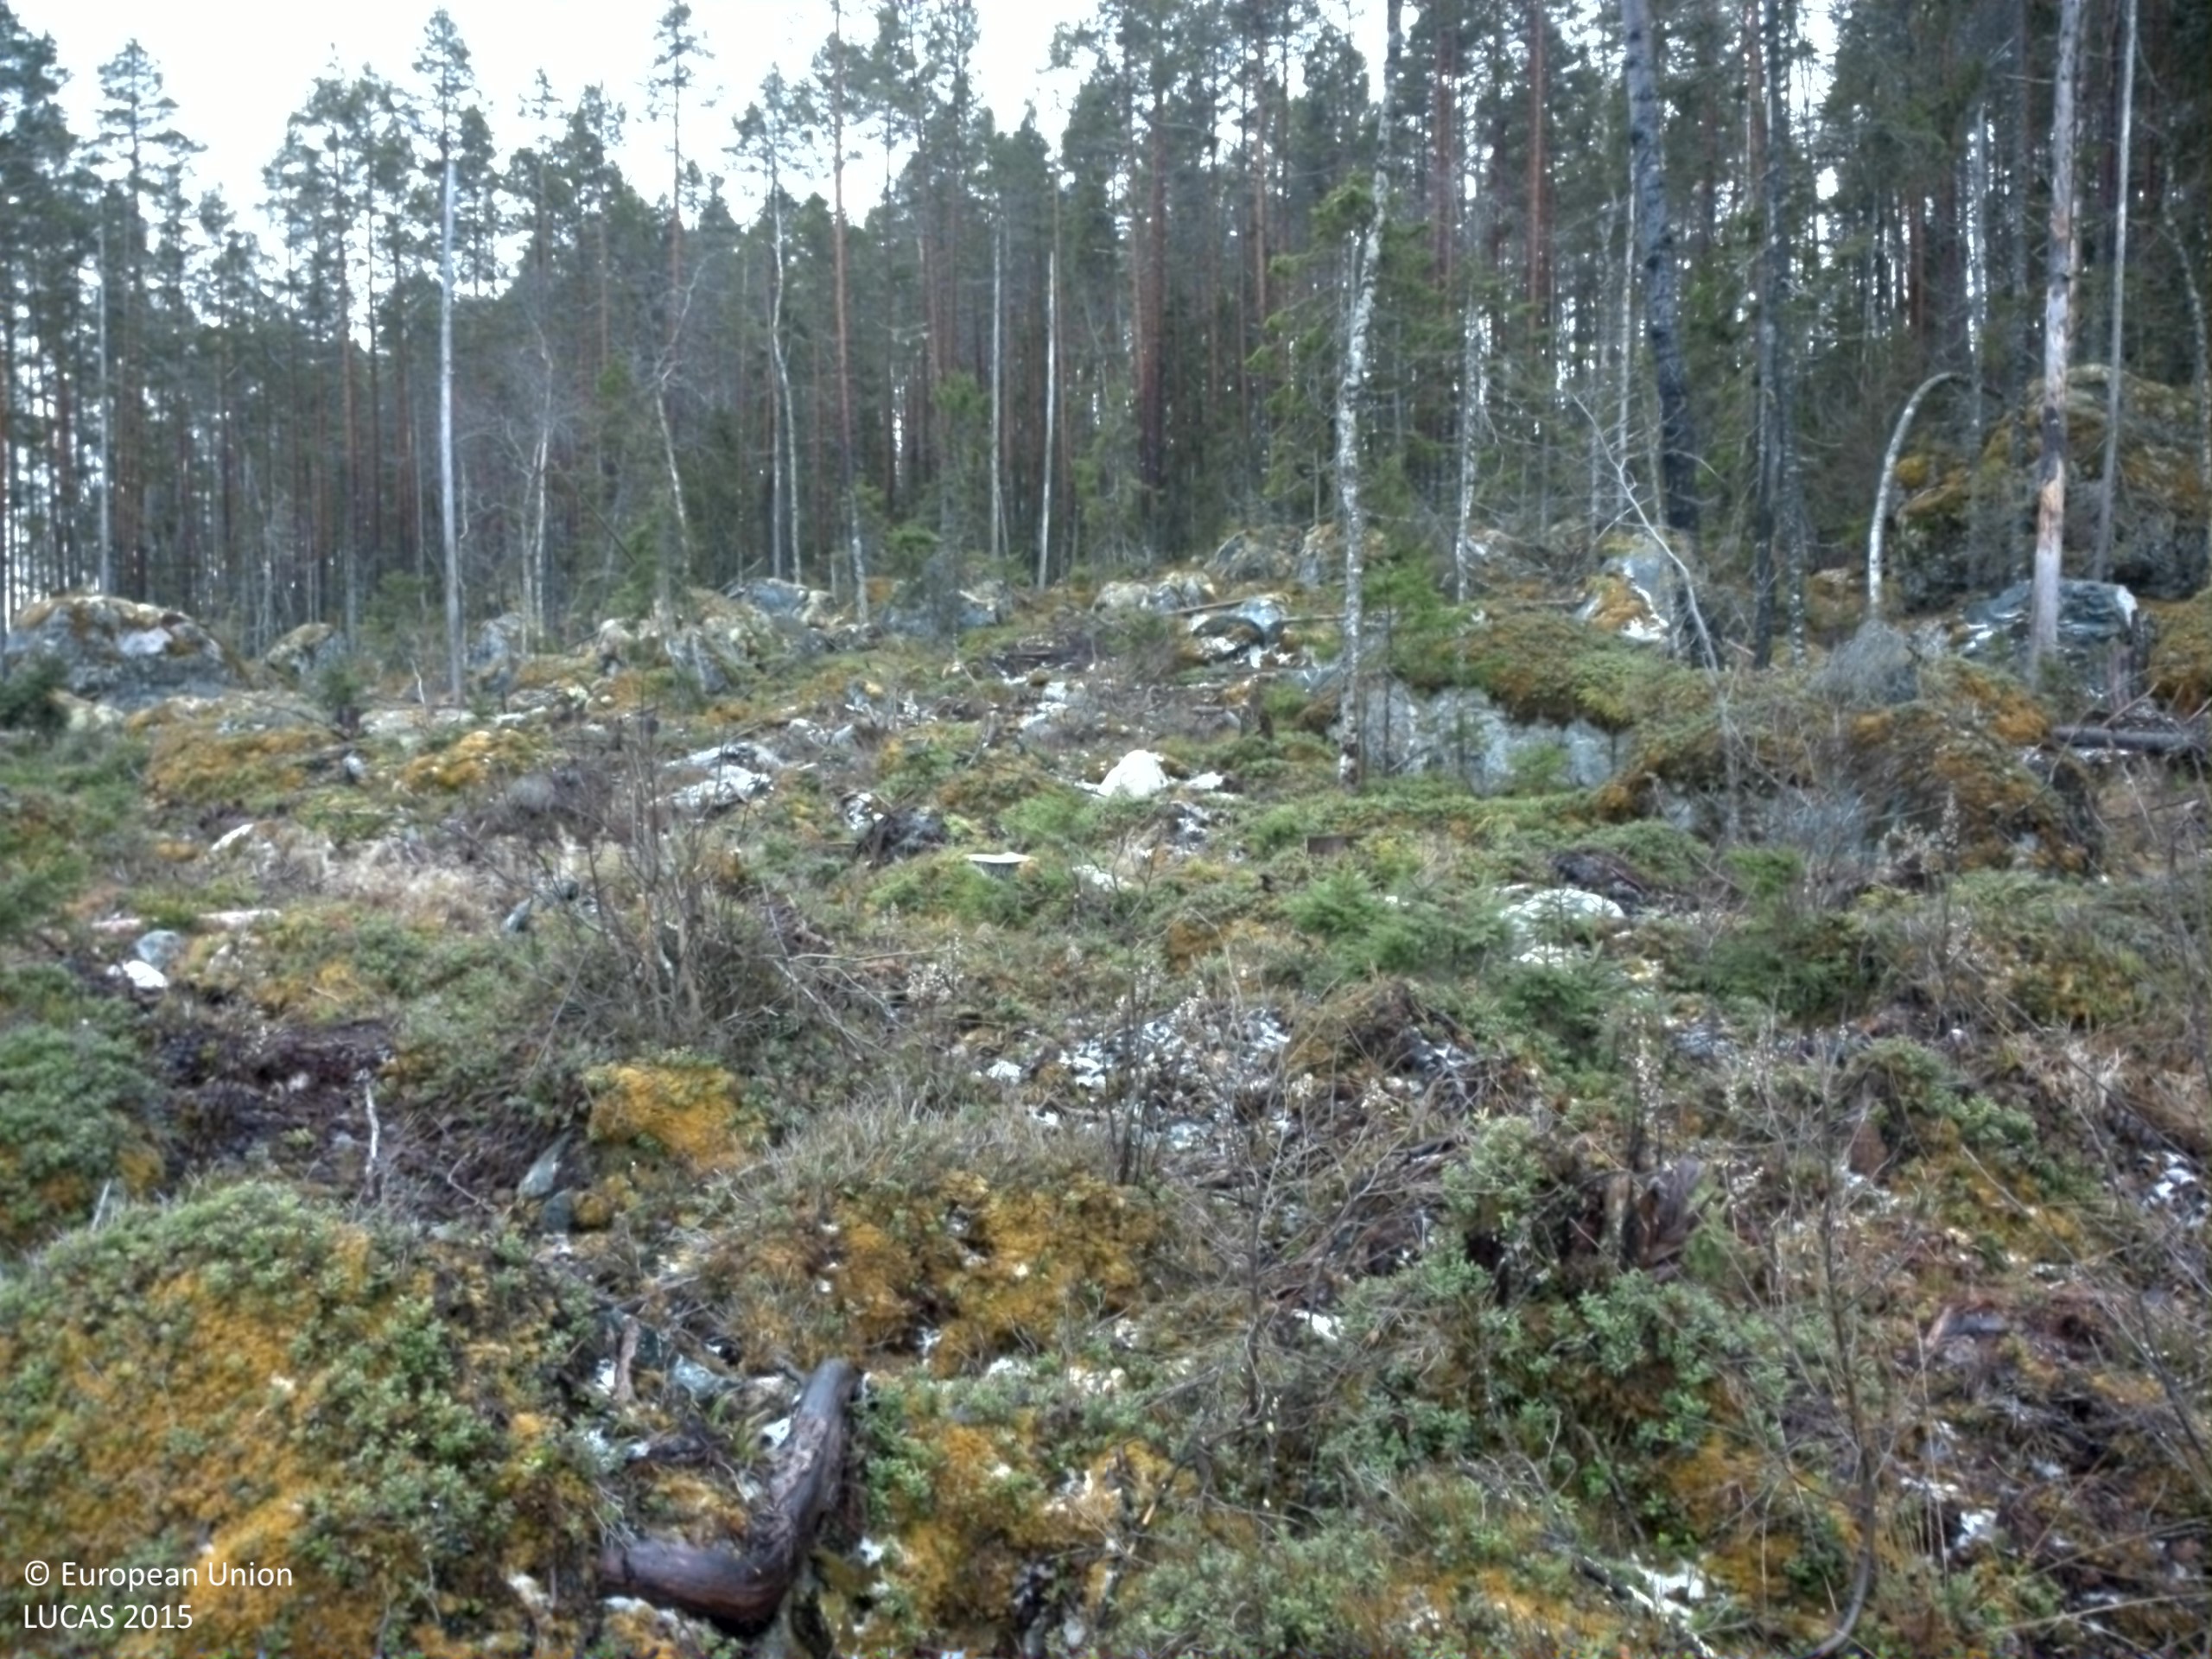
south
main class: Woodland
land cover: Spruce dominated mixed woodland
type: boreal forest
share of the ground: 10 - 25 %
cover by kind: shrubs 35 %, herbaceous plants 20 %, lichens and mosses 20 %, coniferous forest trees 10 %, consolidated bare surface 10 %, broadleaved forest trees 5 %
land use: Forestry
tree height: < 5 m
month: November
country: SE
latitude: 61.4300
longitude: 15.4389
